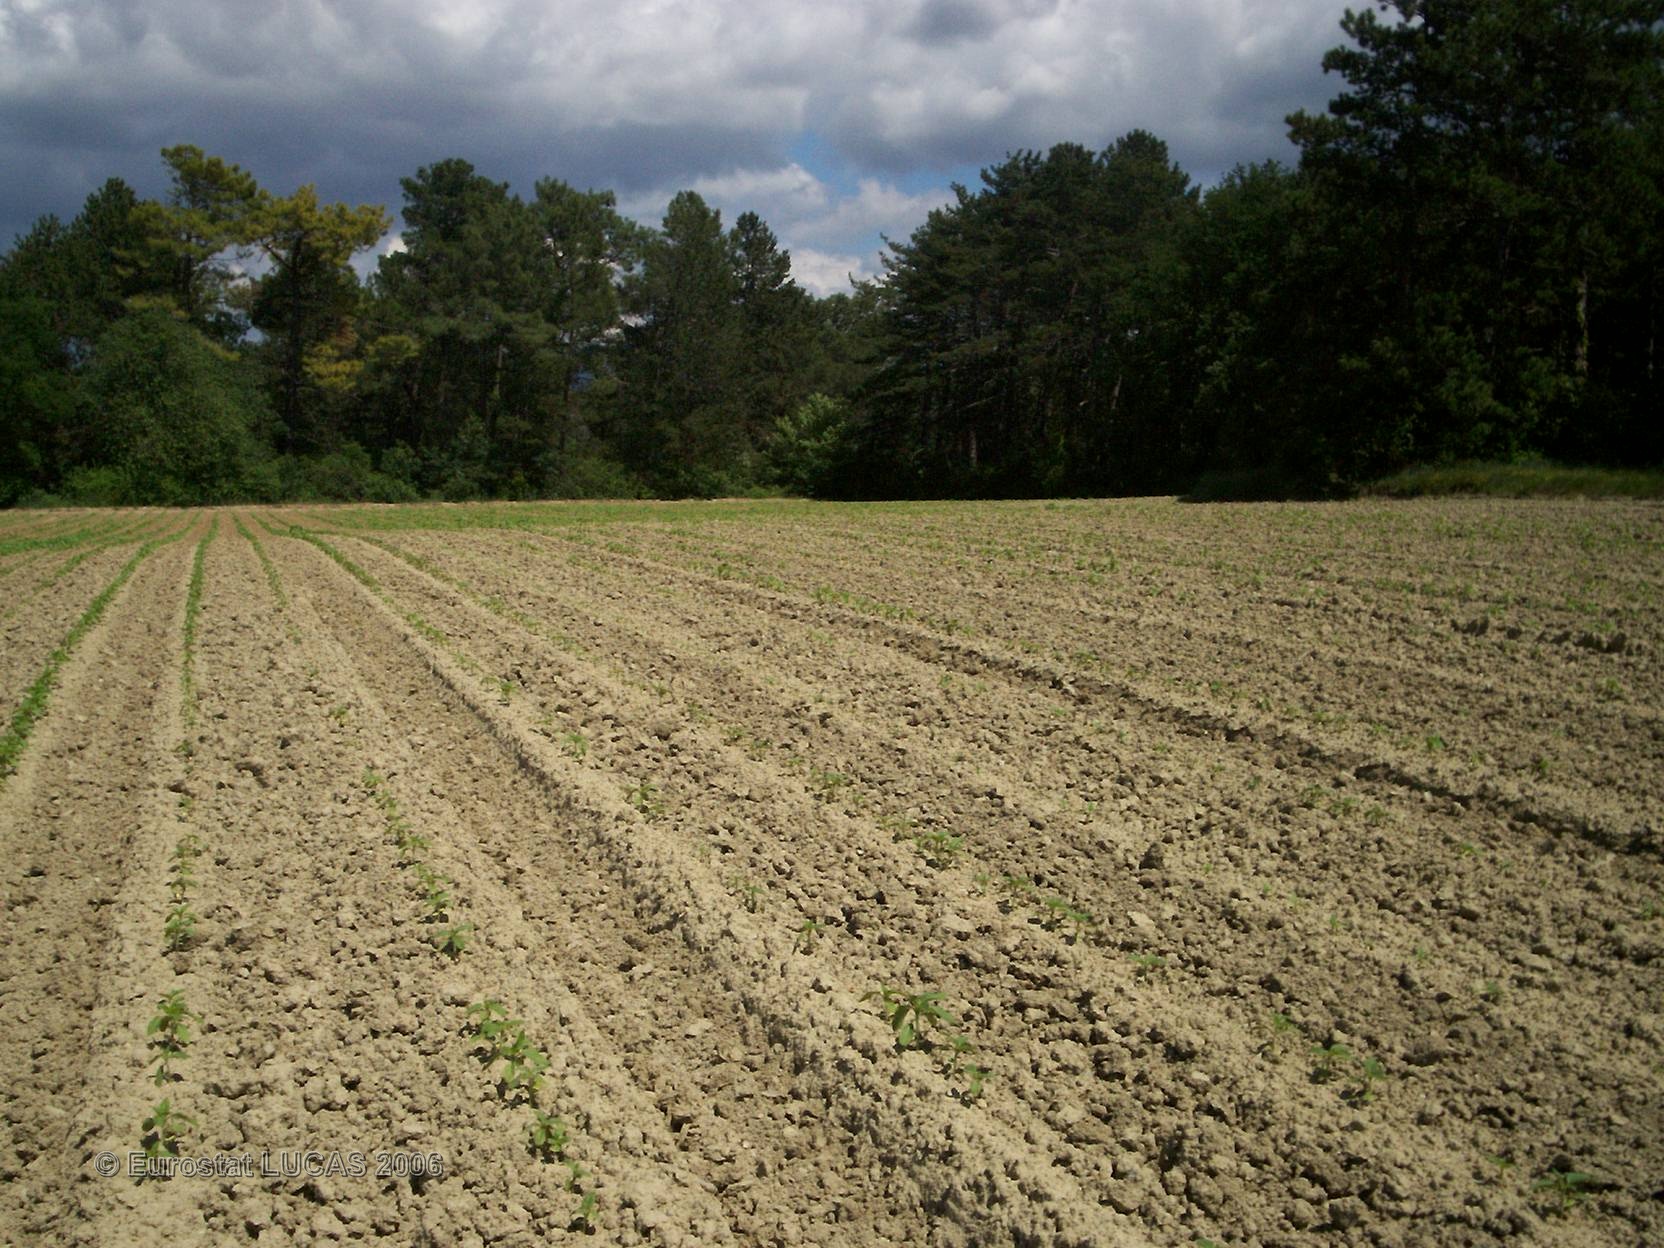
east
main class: Cropland
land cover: Sunflower
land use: Agriculture (excluding fallow land and kitchen gardens)
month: May
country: FR
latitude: 44.5483
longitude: 4.8585
